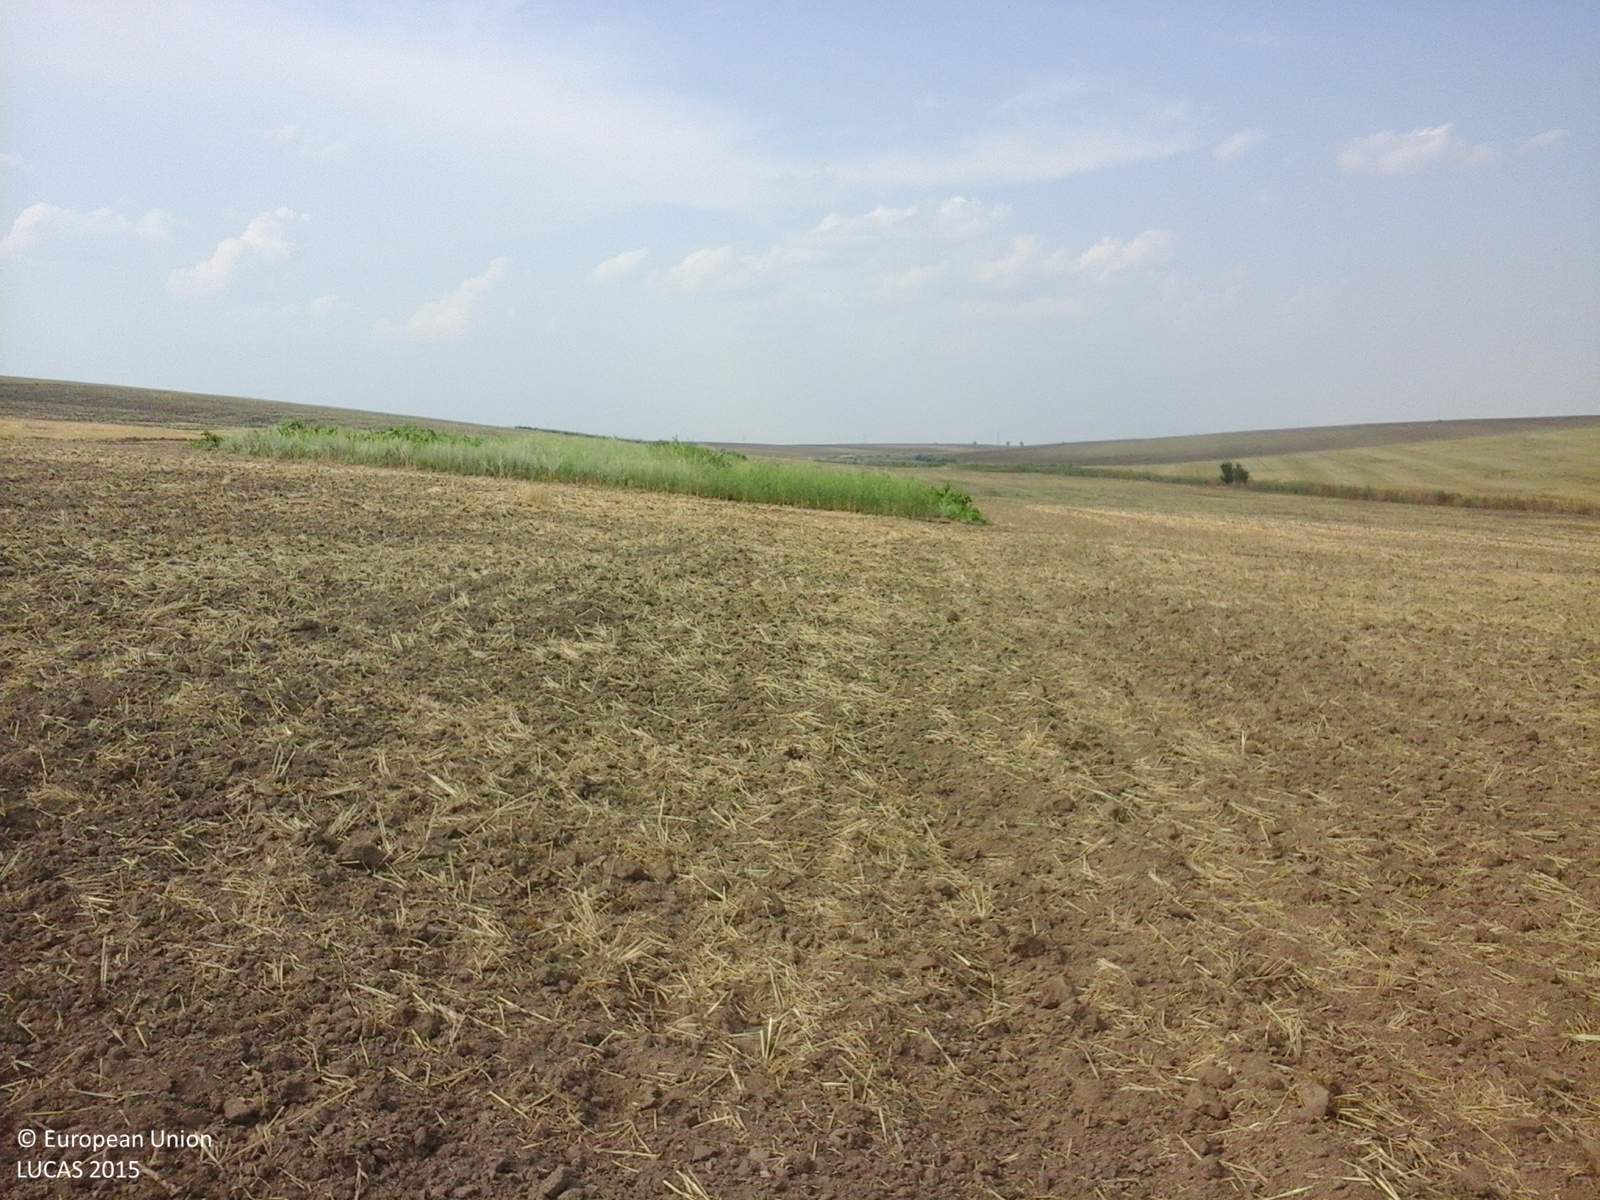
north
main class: Cropland
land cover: Common wheat
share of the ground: 10 - 25 %
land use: Agriculture (excluding fallow land and kitchen gardens)
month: July
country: RO
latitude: 45.4562
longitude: 27.8755
